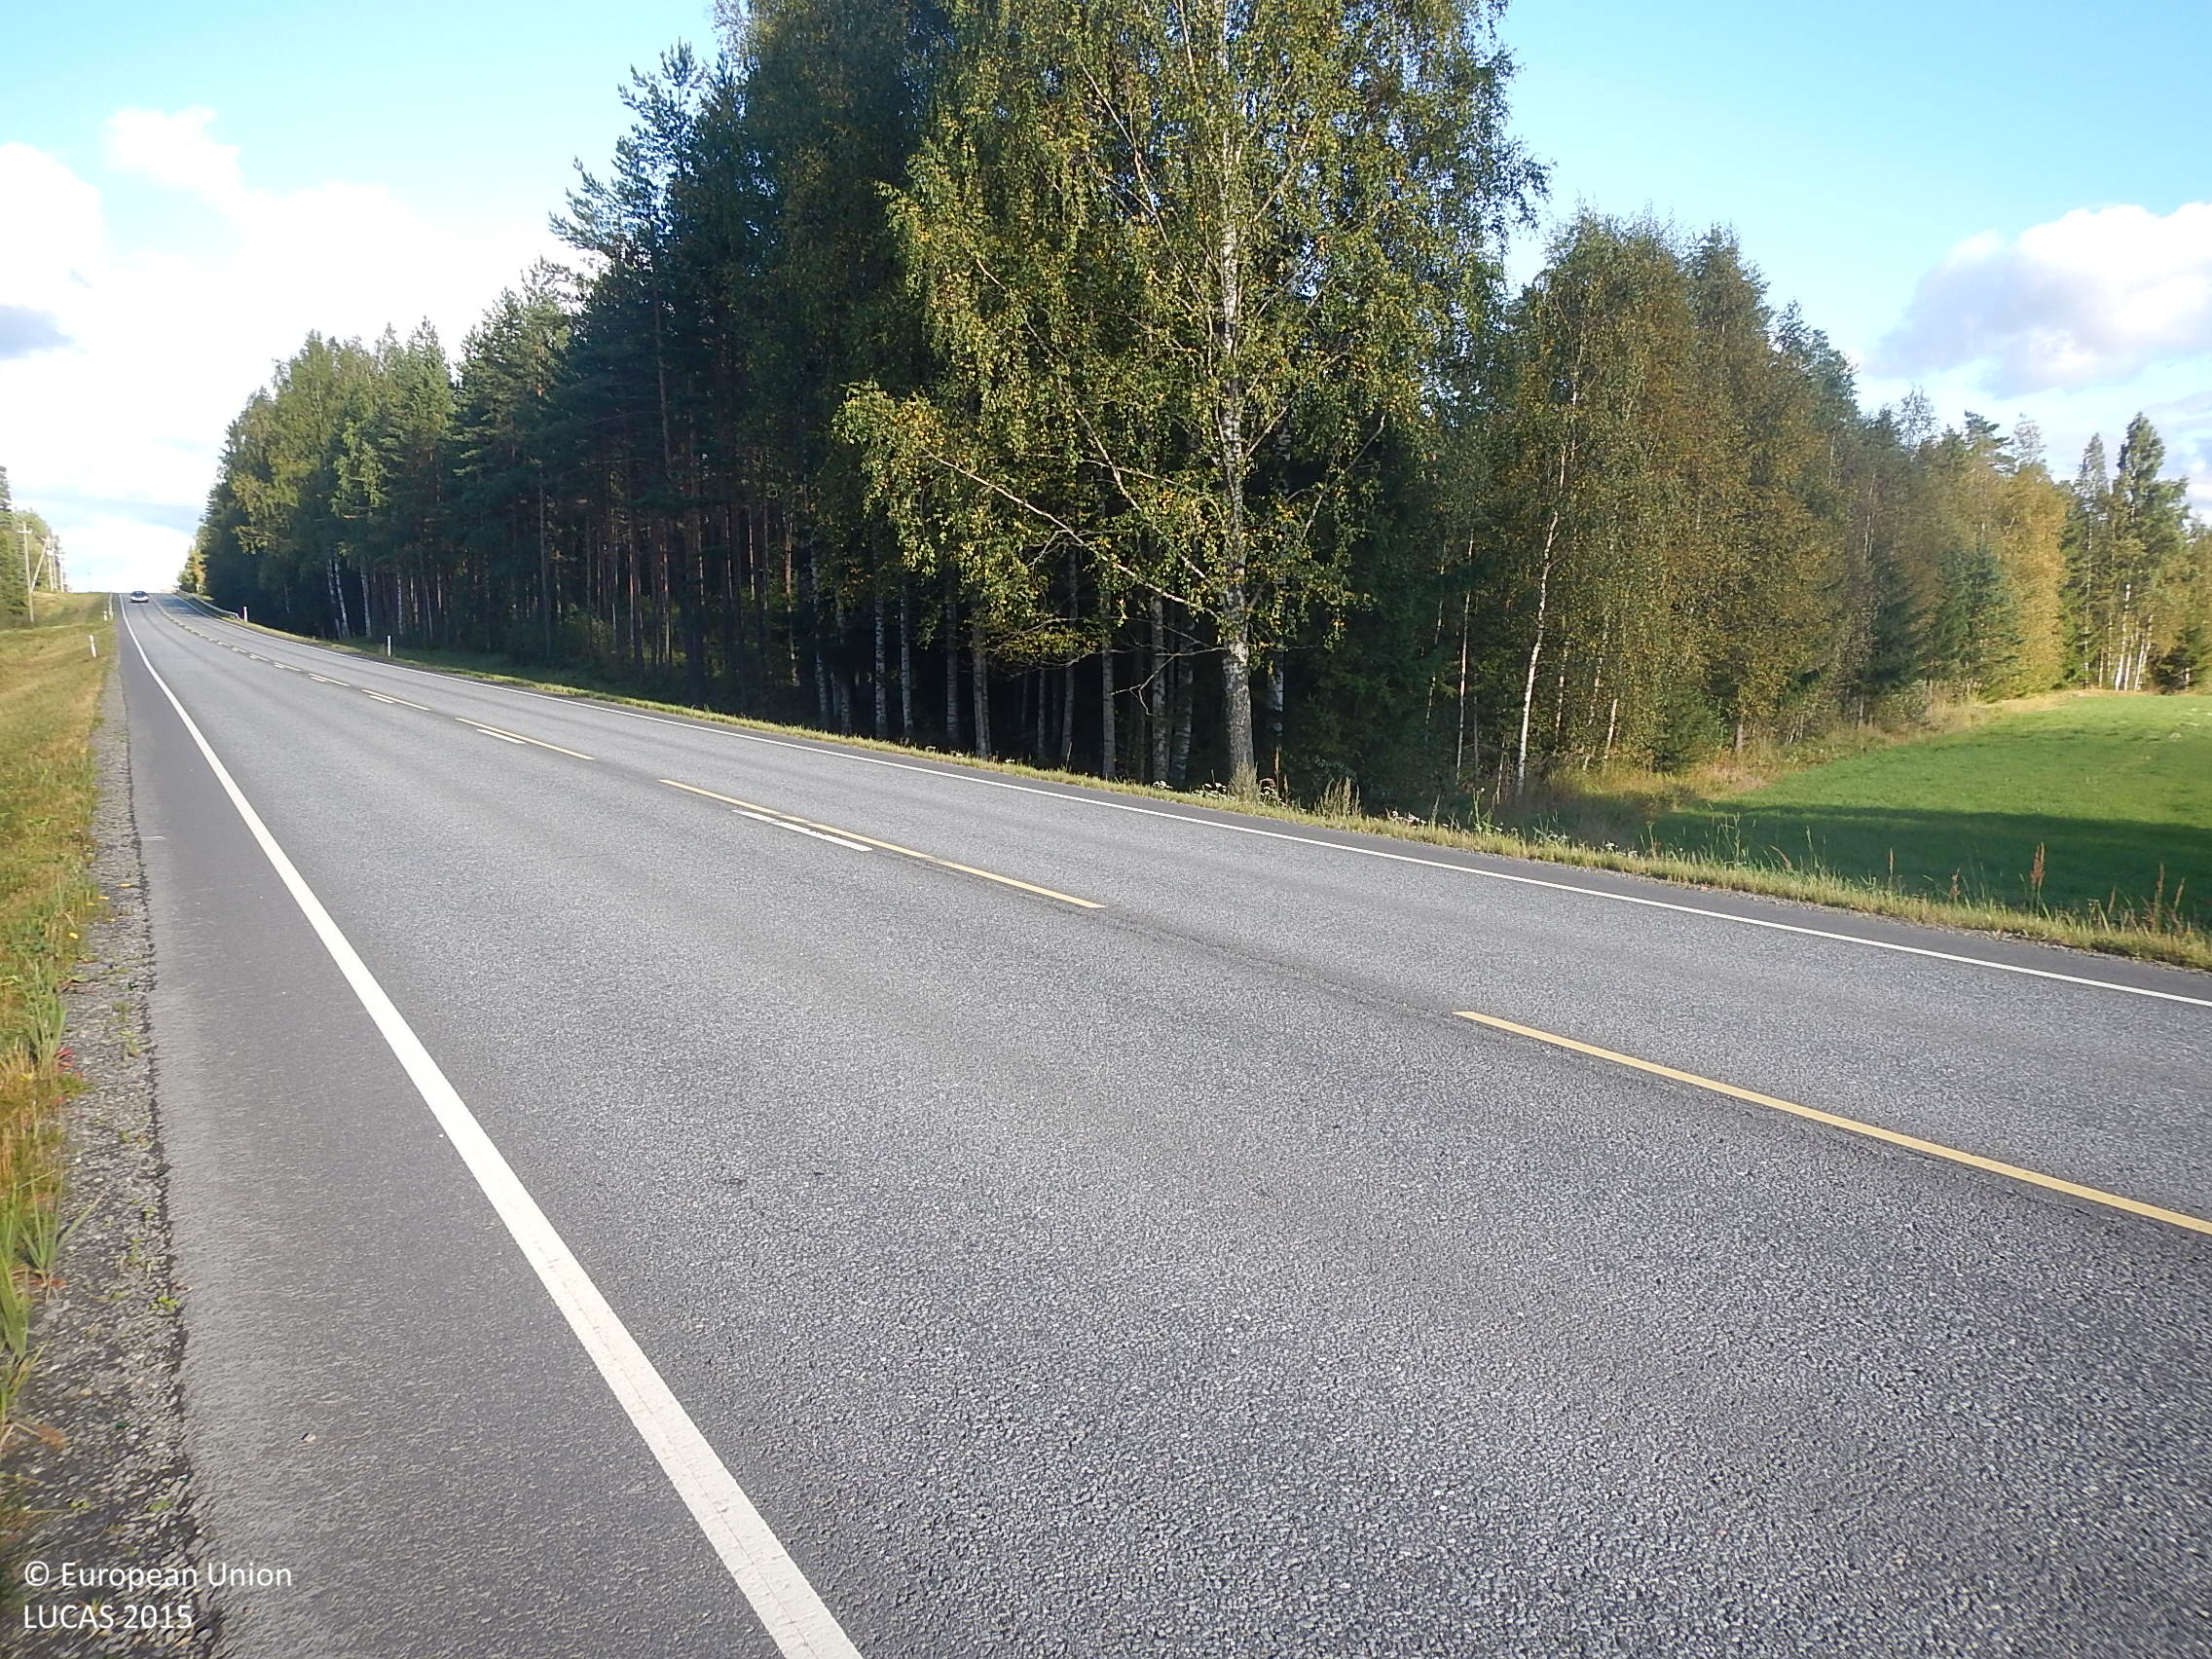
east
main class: Grassland
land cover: Grassland without tree/shrub cover
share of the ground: > 75 %
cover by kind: herbaceous plants 100 %
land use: Road transport
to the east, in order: Grassland without tree/shrub cover; Paved roads, cycling and walking lanes; Grassland without tree/shrub cover; Ditches and canals; Spruce dominated mixed woodland; Pine dominated coniferous woodland; Broadleaved woodland; Inland fresh running water; Spruce dominated mixed woodland; Grassland without tree/shrub cover
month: September
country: FI
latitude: 61.4780
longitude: 22.5868
